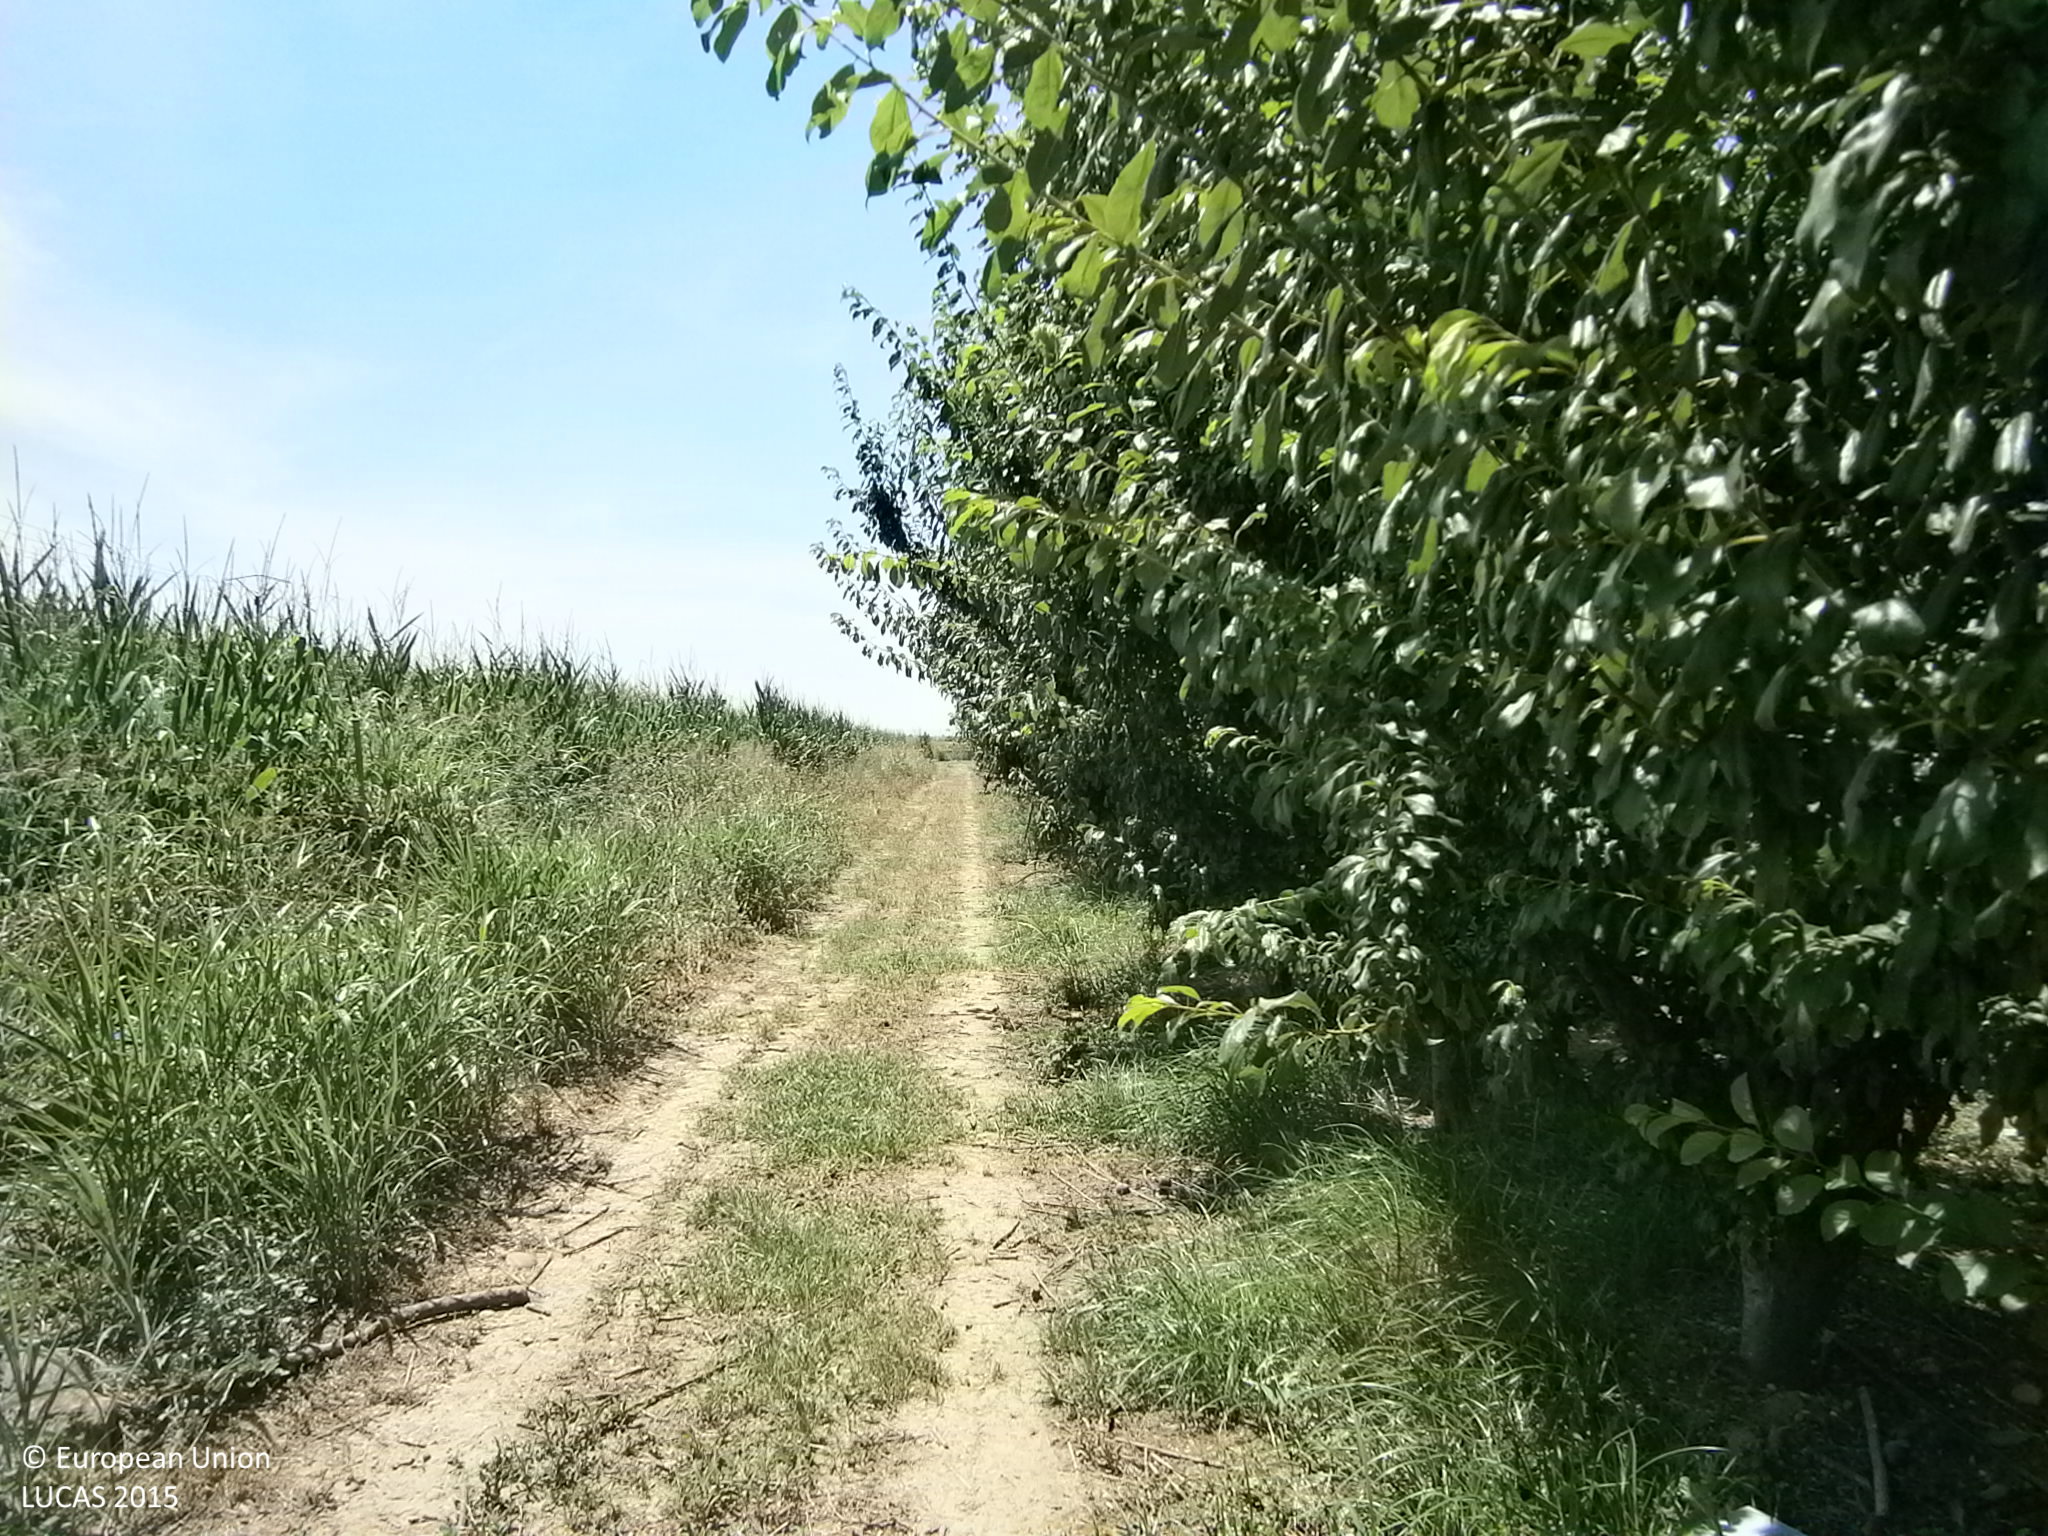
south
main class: Cropland
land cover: Other fruit trees and berries
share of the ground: > 75 %
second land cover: Spontaneously vegetated surfaces
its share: 10 - 25 %
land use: Agriculture (excluding fallow land and kitchen gardens)
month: June
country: ES
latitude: 38.9018
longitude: -6.6800
